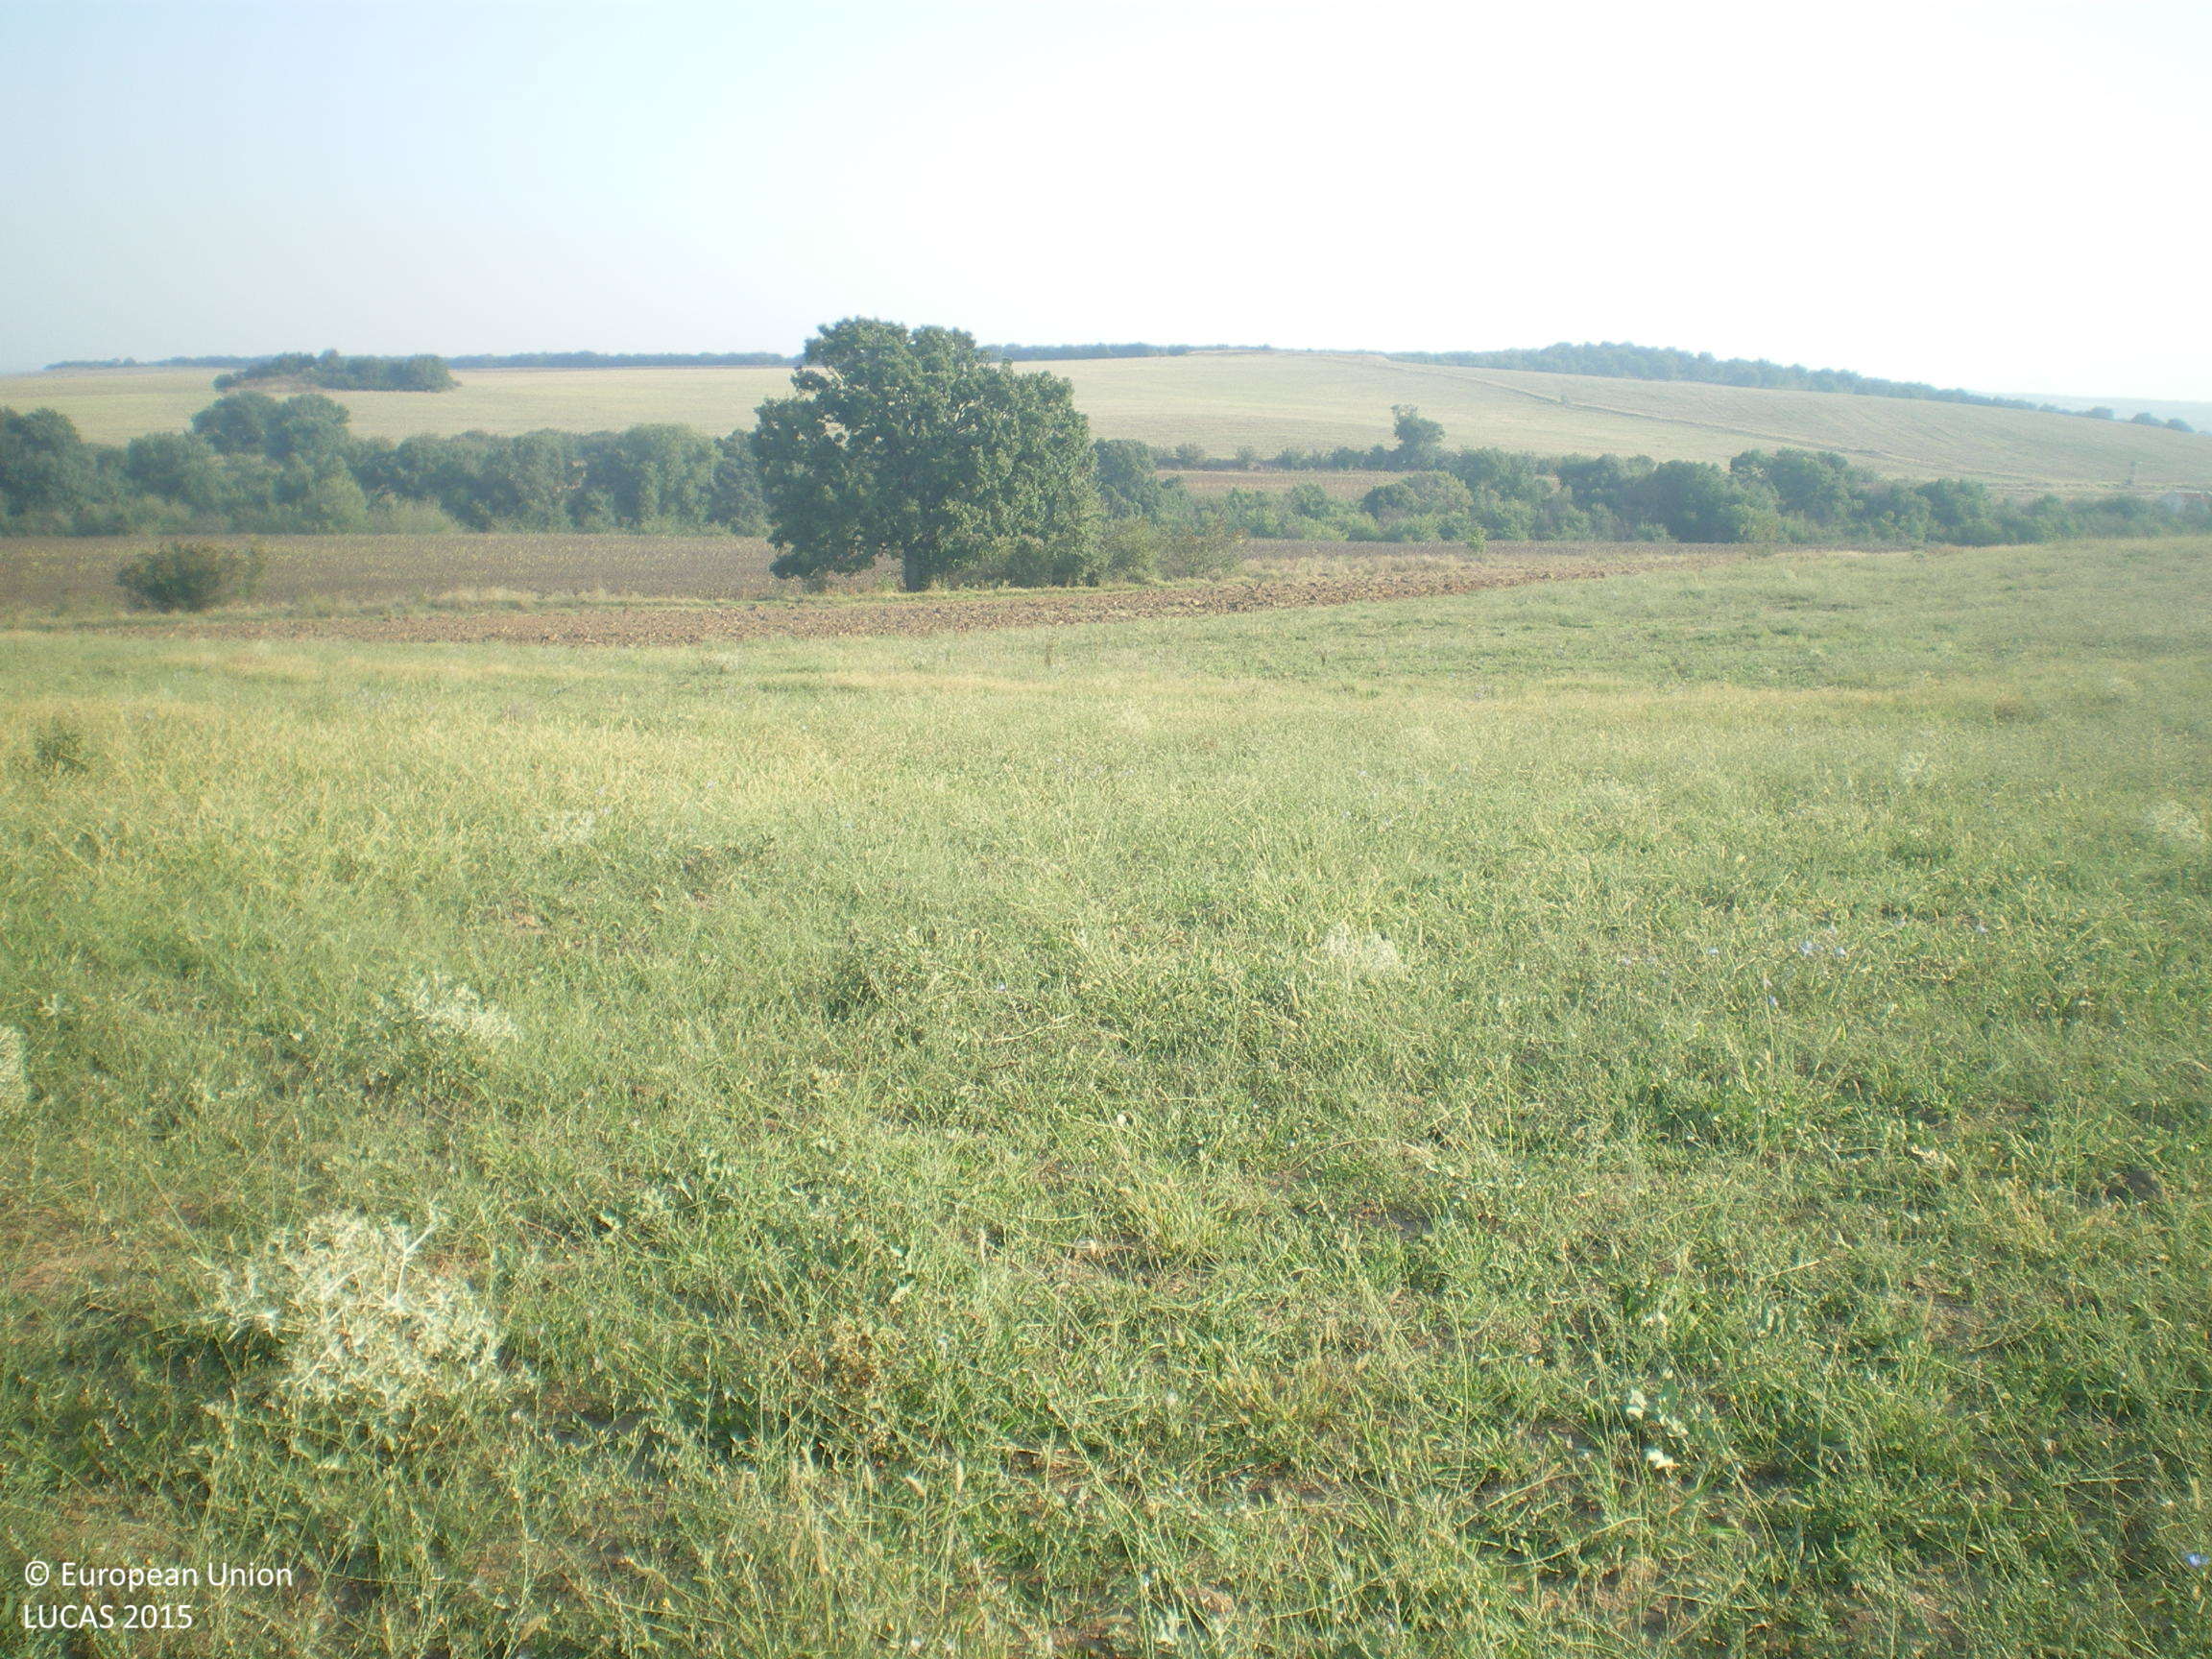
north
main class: Grassland
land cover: Grassland without tree/shrub cover
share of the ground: > 75 %
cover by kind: herbaceous plants 100 %
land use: Agriculture (excluding fallow land and kitchen gardens)
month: August
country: BG
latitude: 42.0128
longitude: 25.9031
